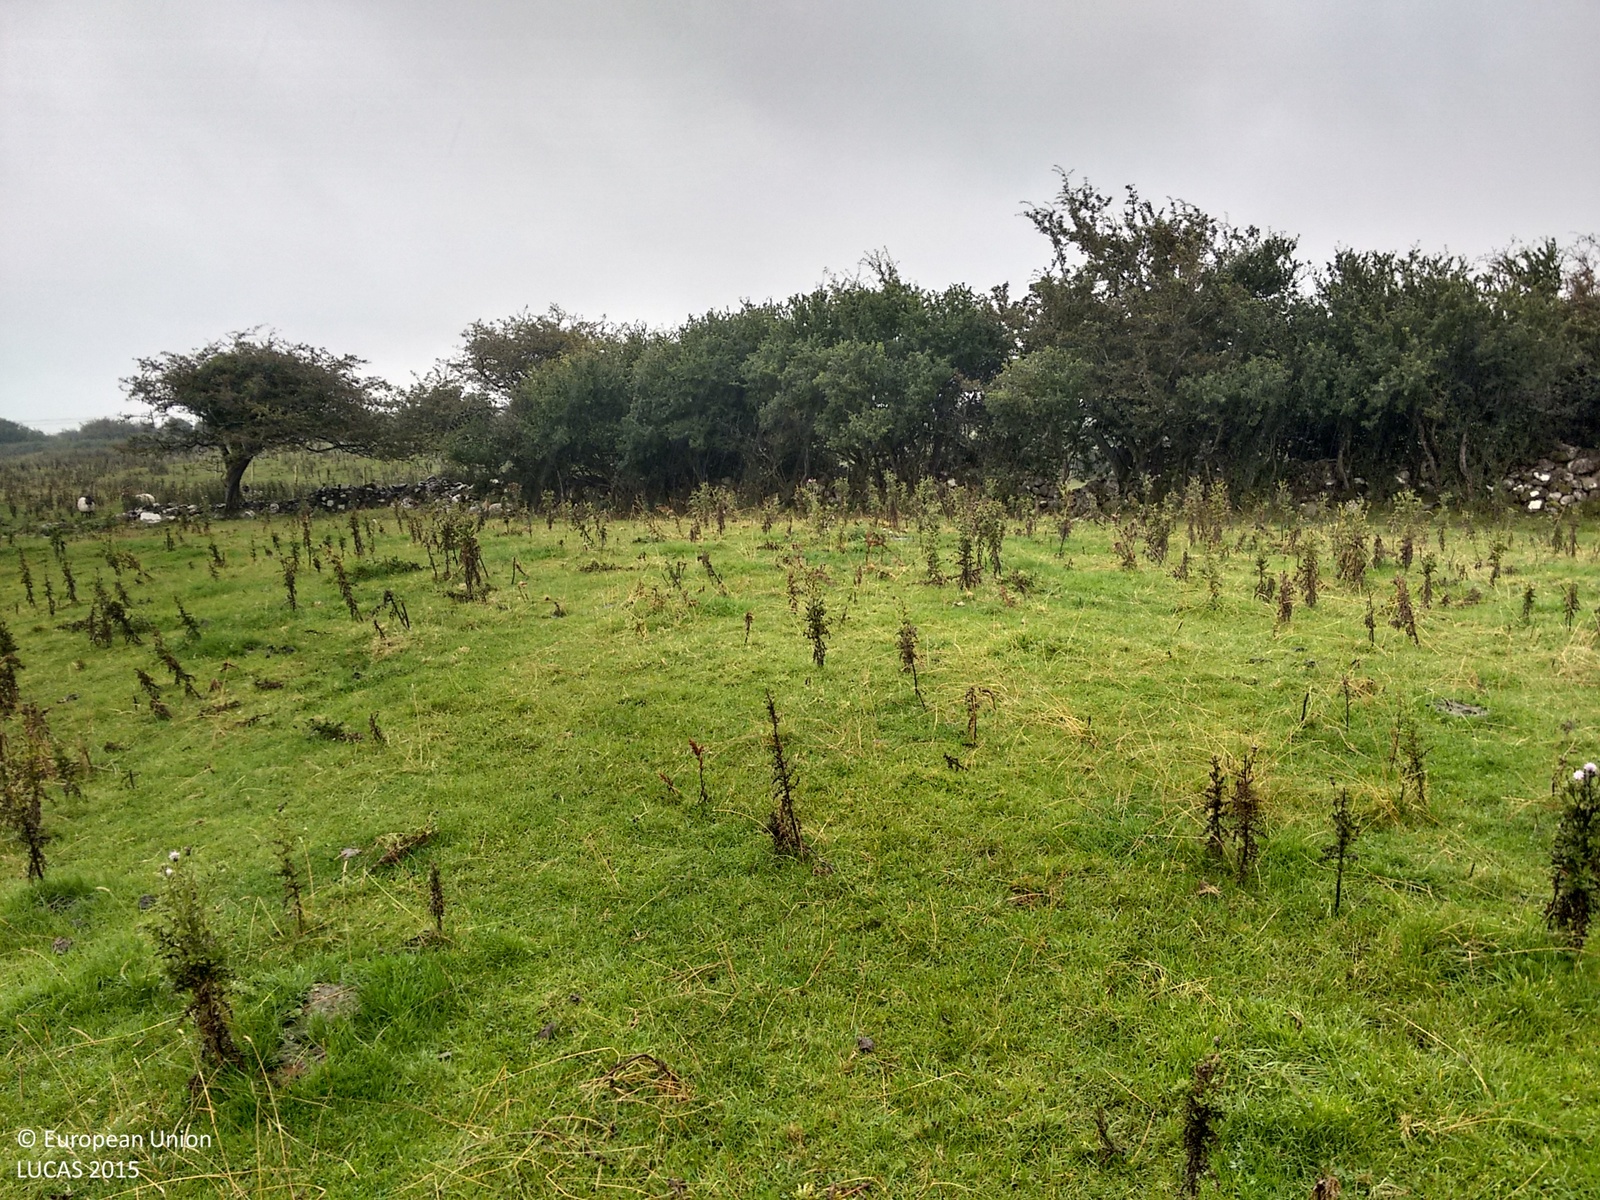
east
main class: Grassland
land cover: Grassland without tree/shrub cover
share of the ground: > 75 %
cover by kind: herbaceous plants 100 %
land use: Agriculture (excluding fallow land and kitchen gardens)
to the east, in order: Grassland without tree/shrub cover; Broadleaved woodland; Dry stone walls; Broadleaved woodland; Grassland without tree/shrub cover; Inland marshes; Electric lines; Grassland without tree/shrub cover; Fences; Artificial constructions; Paved roads, cycling and walking lanes; Artificial constructions; Fences; Grassland with sparse tree/shrub cover; Fences; Tracks; Fences; Grassland with sparse tree/shrub cover; Abandoned hedges; Grassland with sparse tree/shrub cover
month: September
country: IE
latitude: 54.0800
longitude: -9.3468
